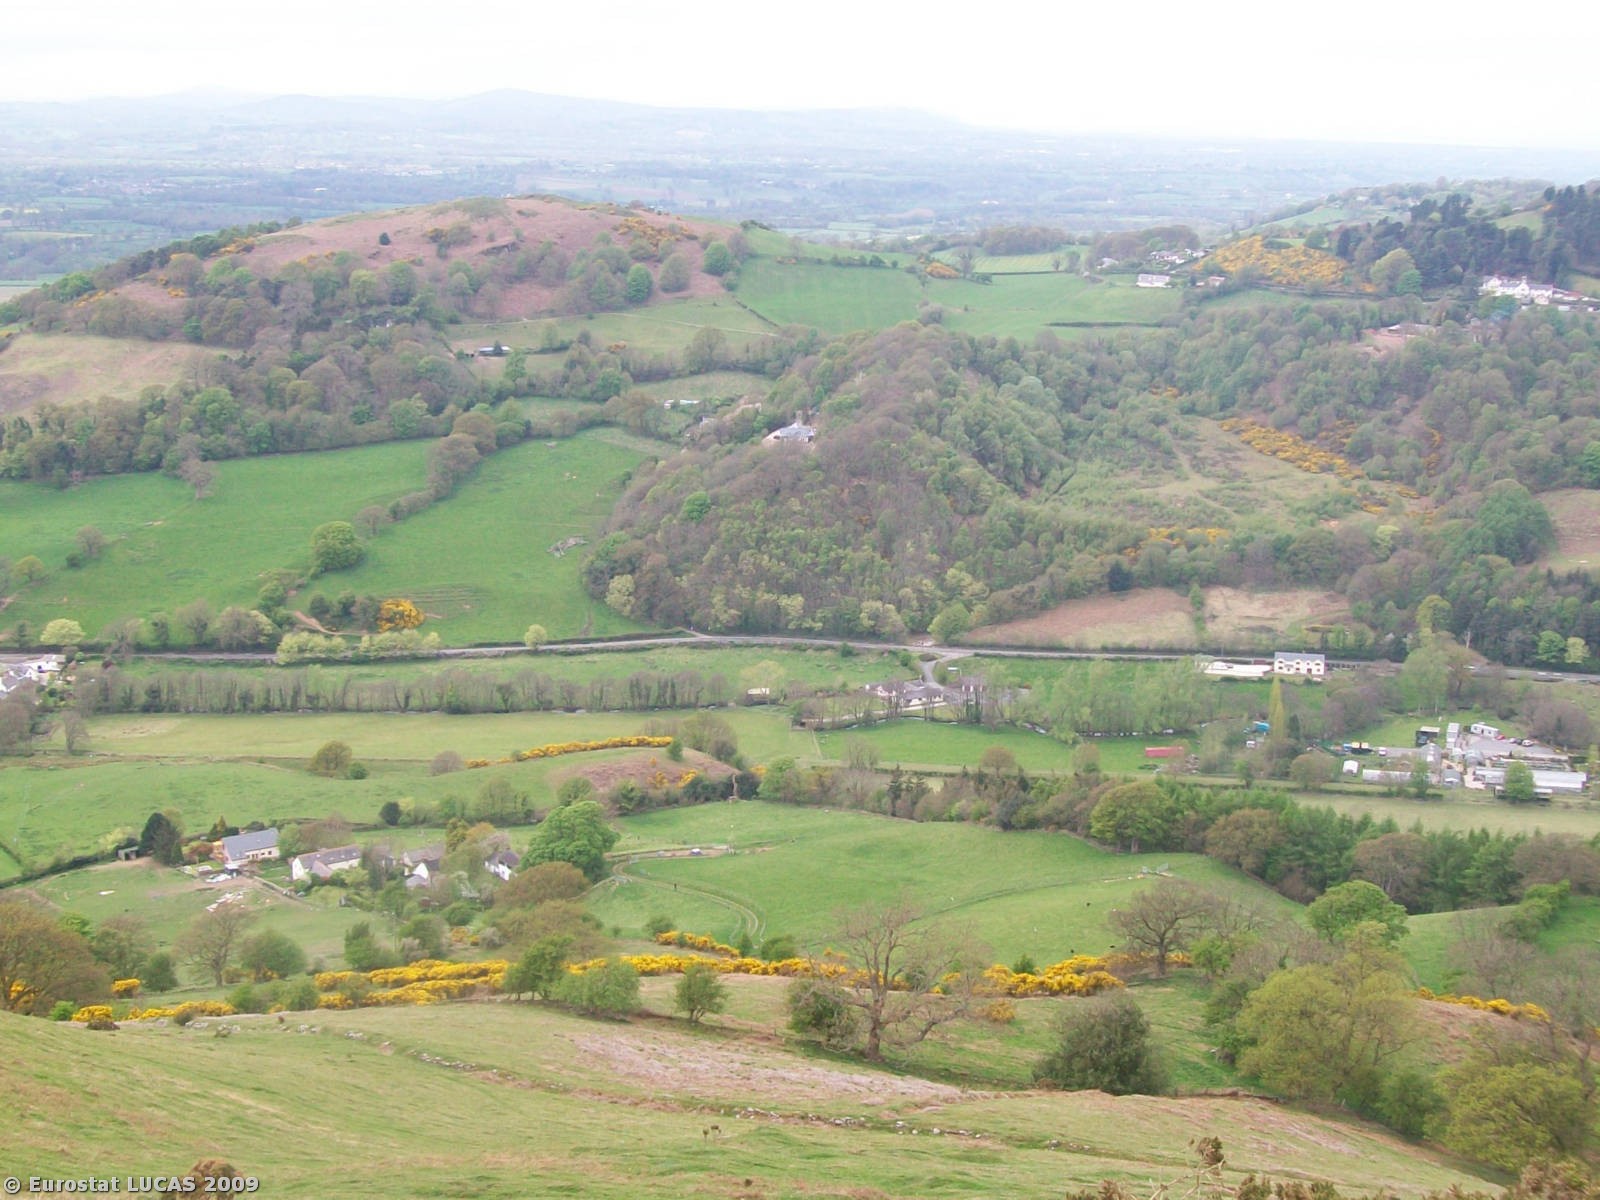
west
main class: Shrubland
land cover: Shrubland without tree cover
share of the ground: > 75 %
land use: Agriculture (excluding fallow land and kitchen gardens)
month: April
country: GB
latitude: 53.2252
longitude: -3.3369
